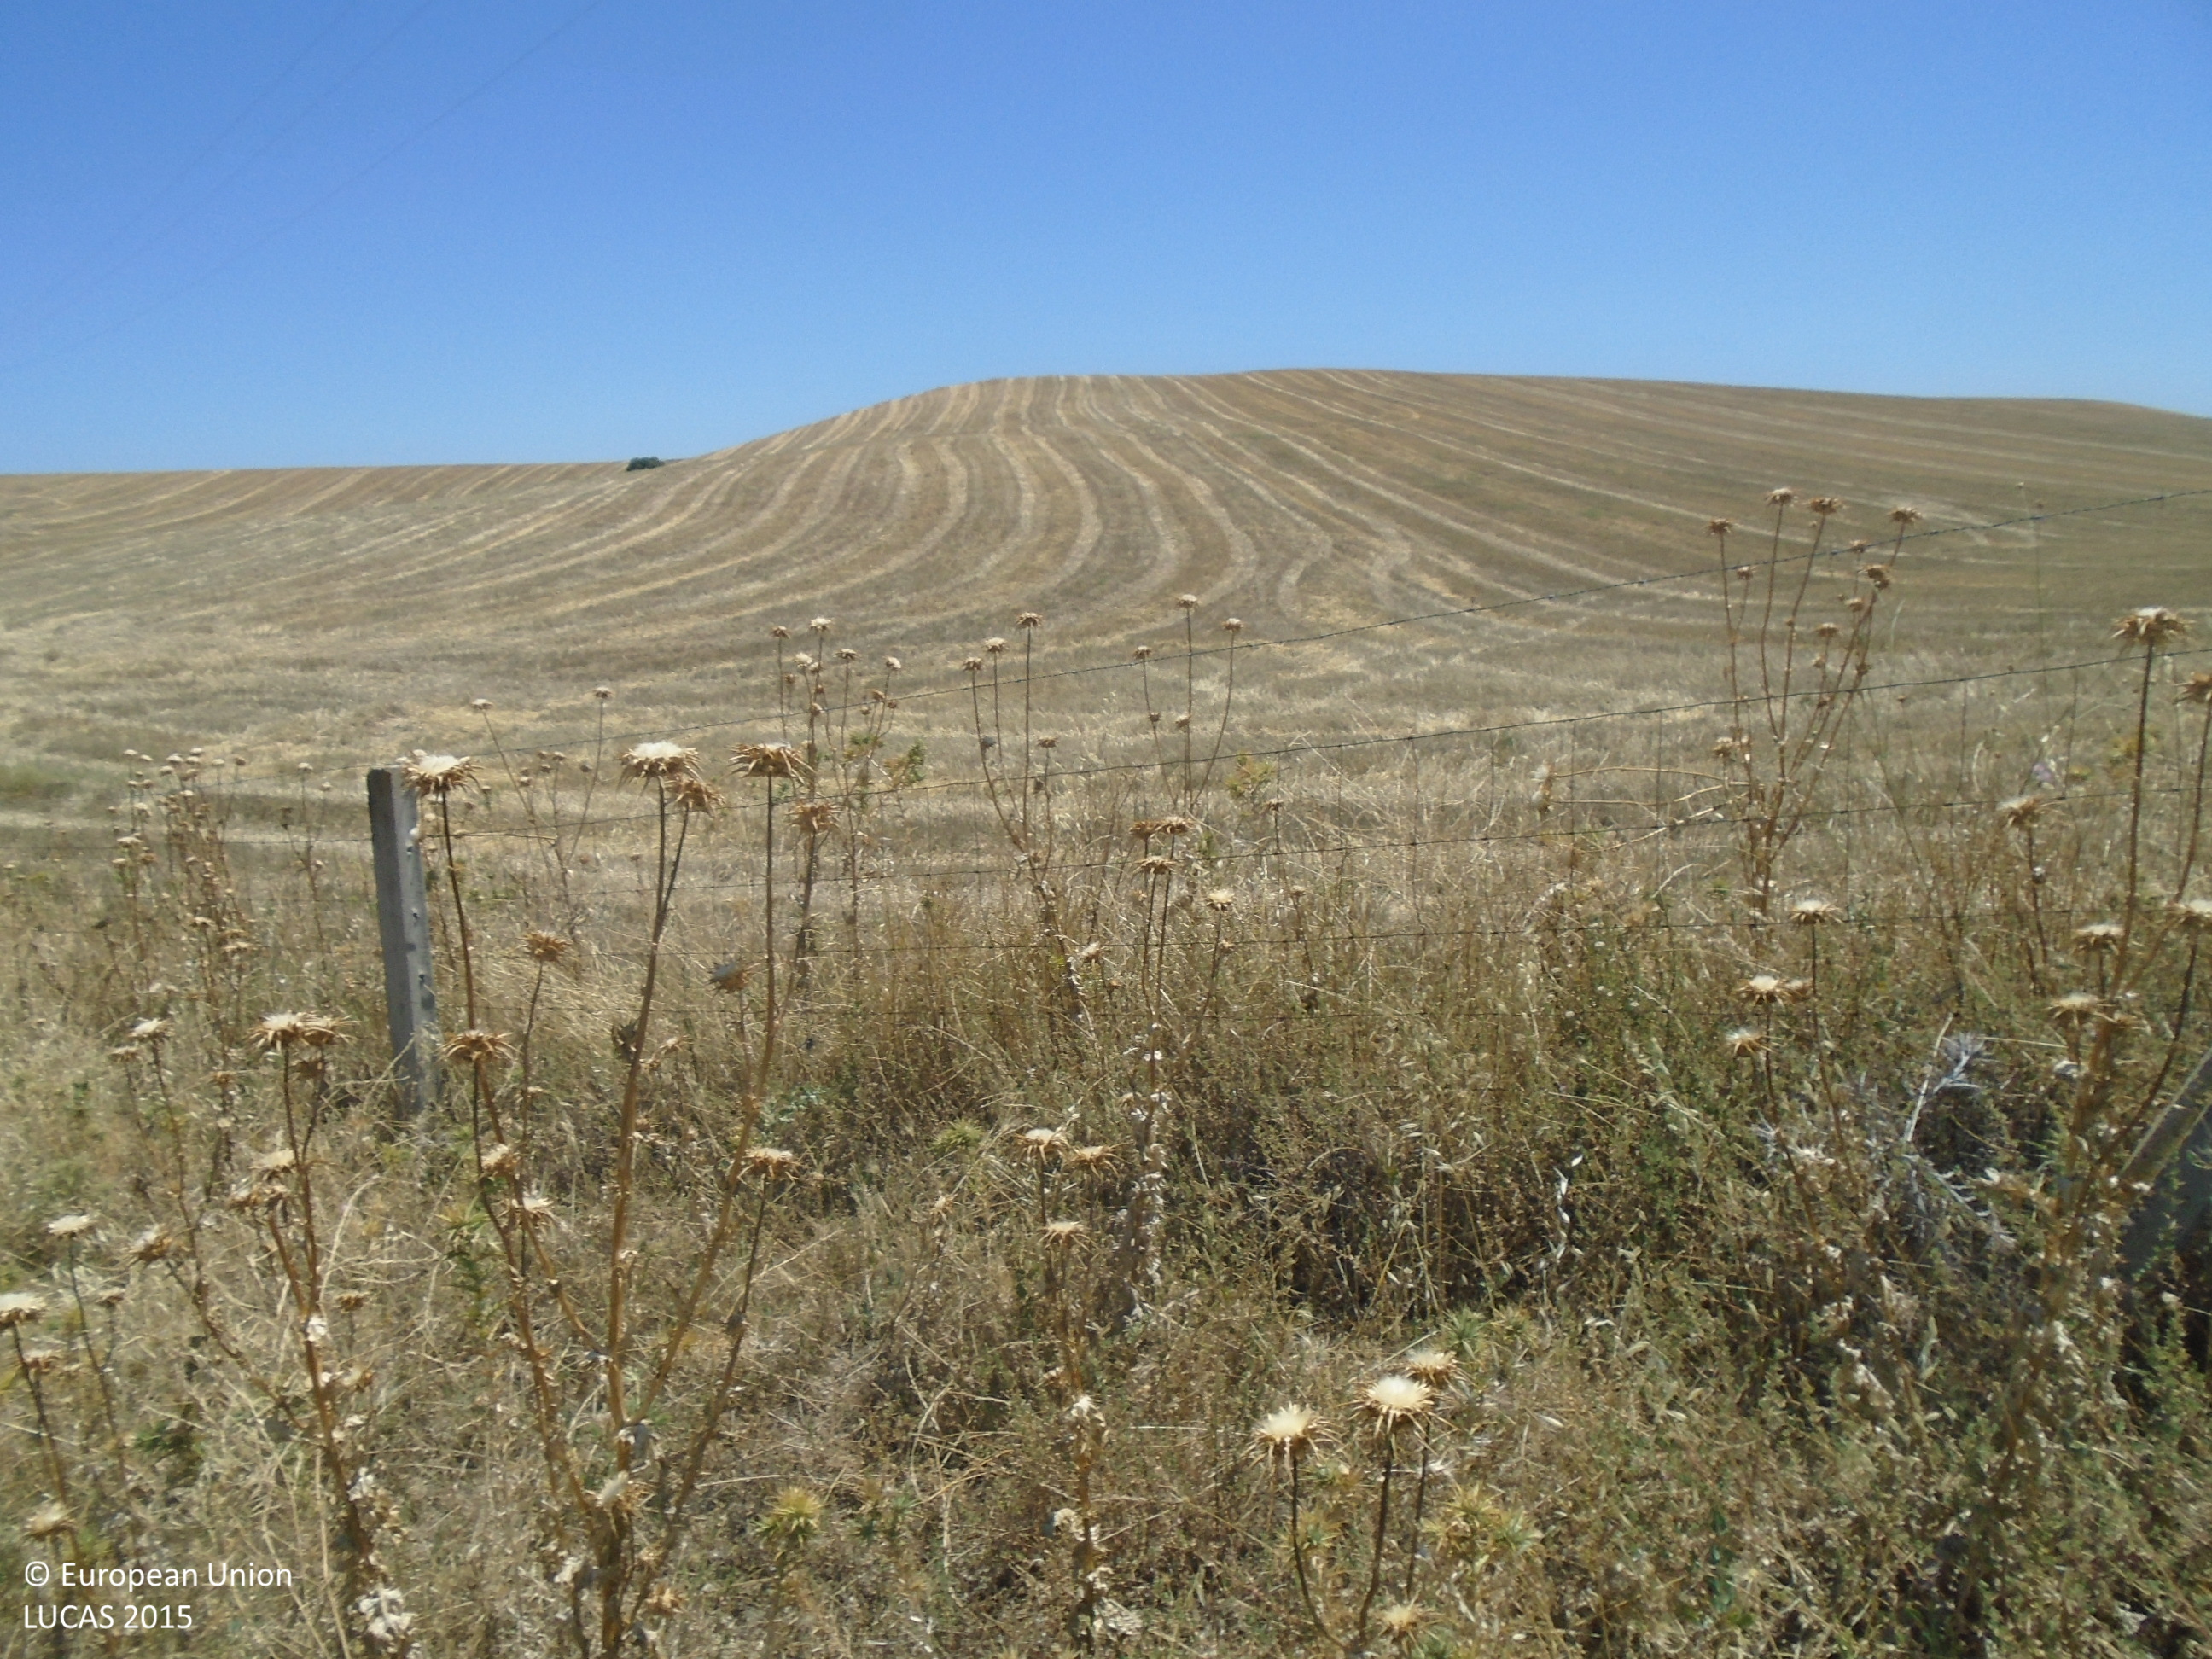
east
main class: Cropland
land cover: Common wheat
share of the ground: > 75 %
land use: Agriculture (excluding fallow land and kitchen gardens)
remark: Harvested field
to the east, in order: Common wheat
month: July
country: ES
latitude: 39.7784
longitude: -4.9331
